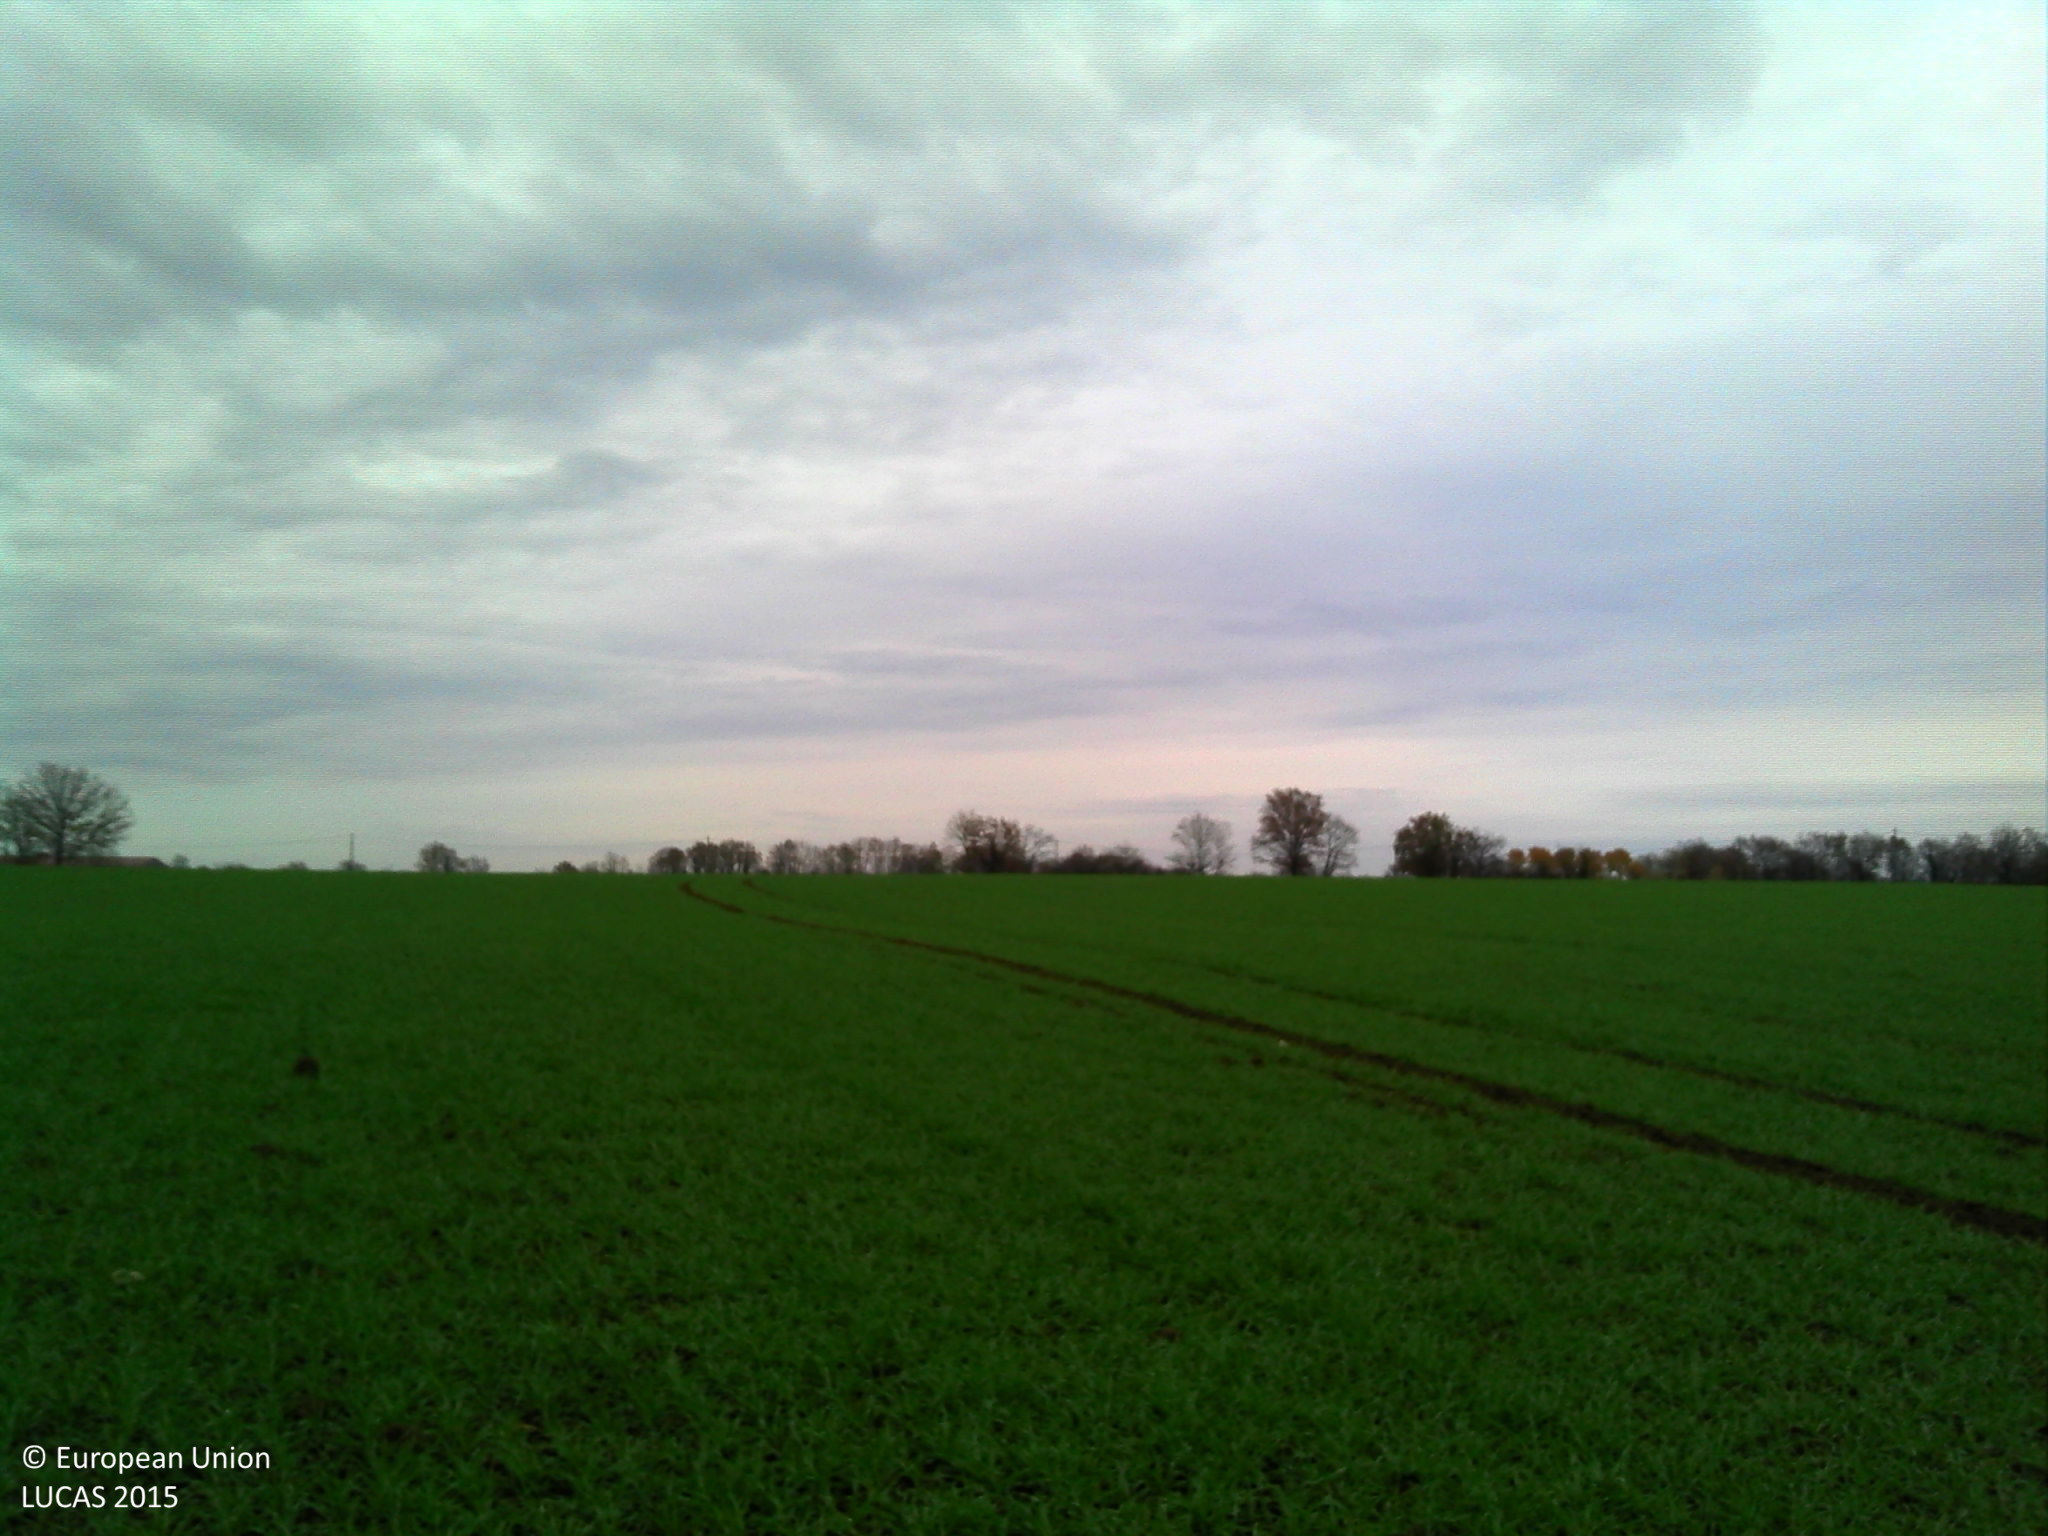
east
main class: Cropland
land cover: Common wheat
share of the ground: > 75 %
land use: Agriculture (excluding fallow land and kitchen gardens)
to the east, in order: Common wheat
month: December
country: FR
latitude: 46.1329
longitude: 5.1493
